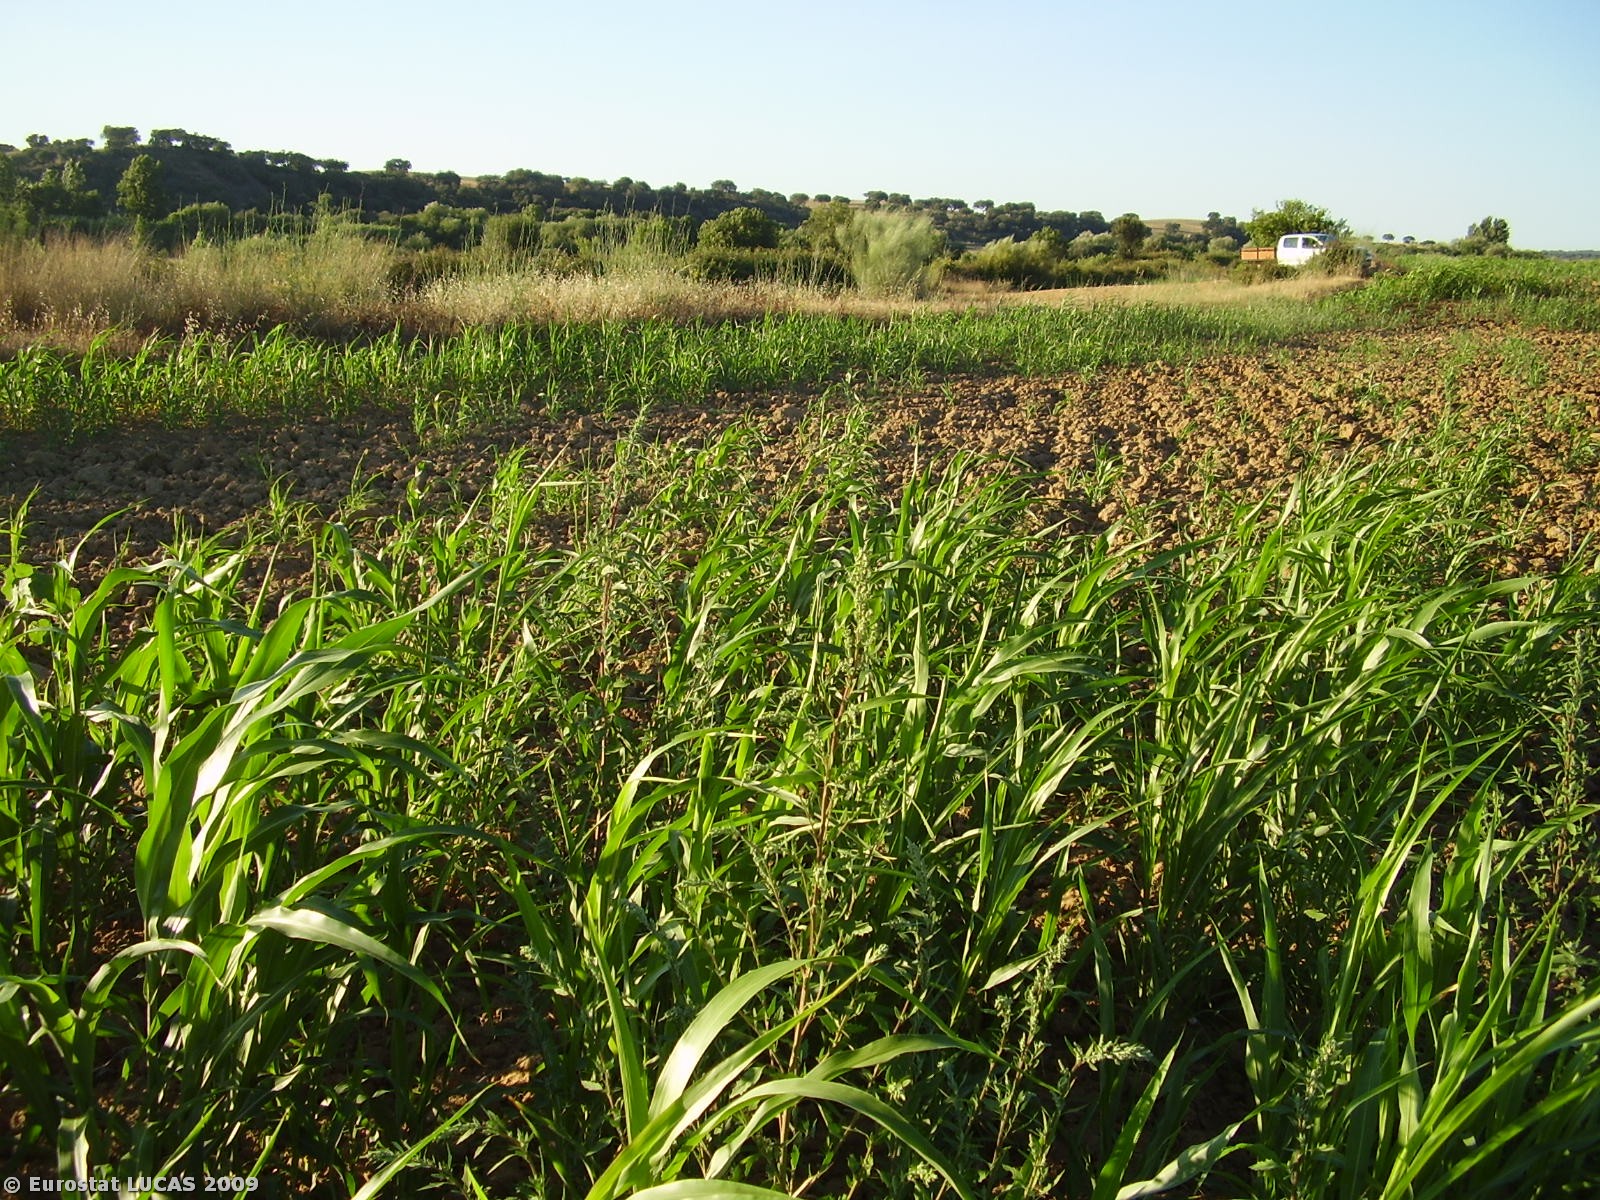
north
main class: Cropland
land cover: Maize
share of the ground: > 75 %
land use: Agriculture (excluding fallow land and kitchen gardens)
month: July
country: PT
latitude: 38.9537
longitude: -8.0159
